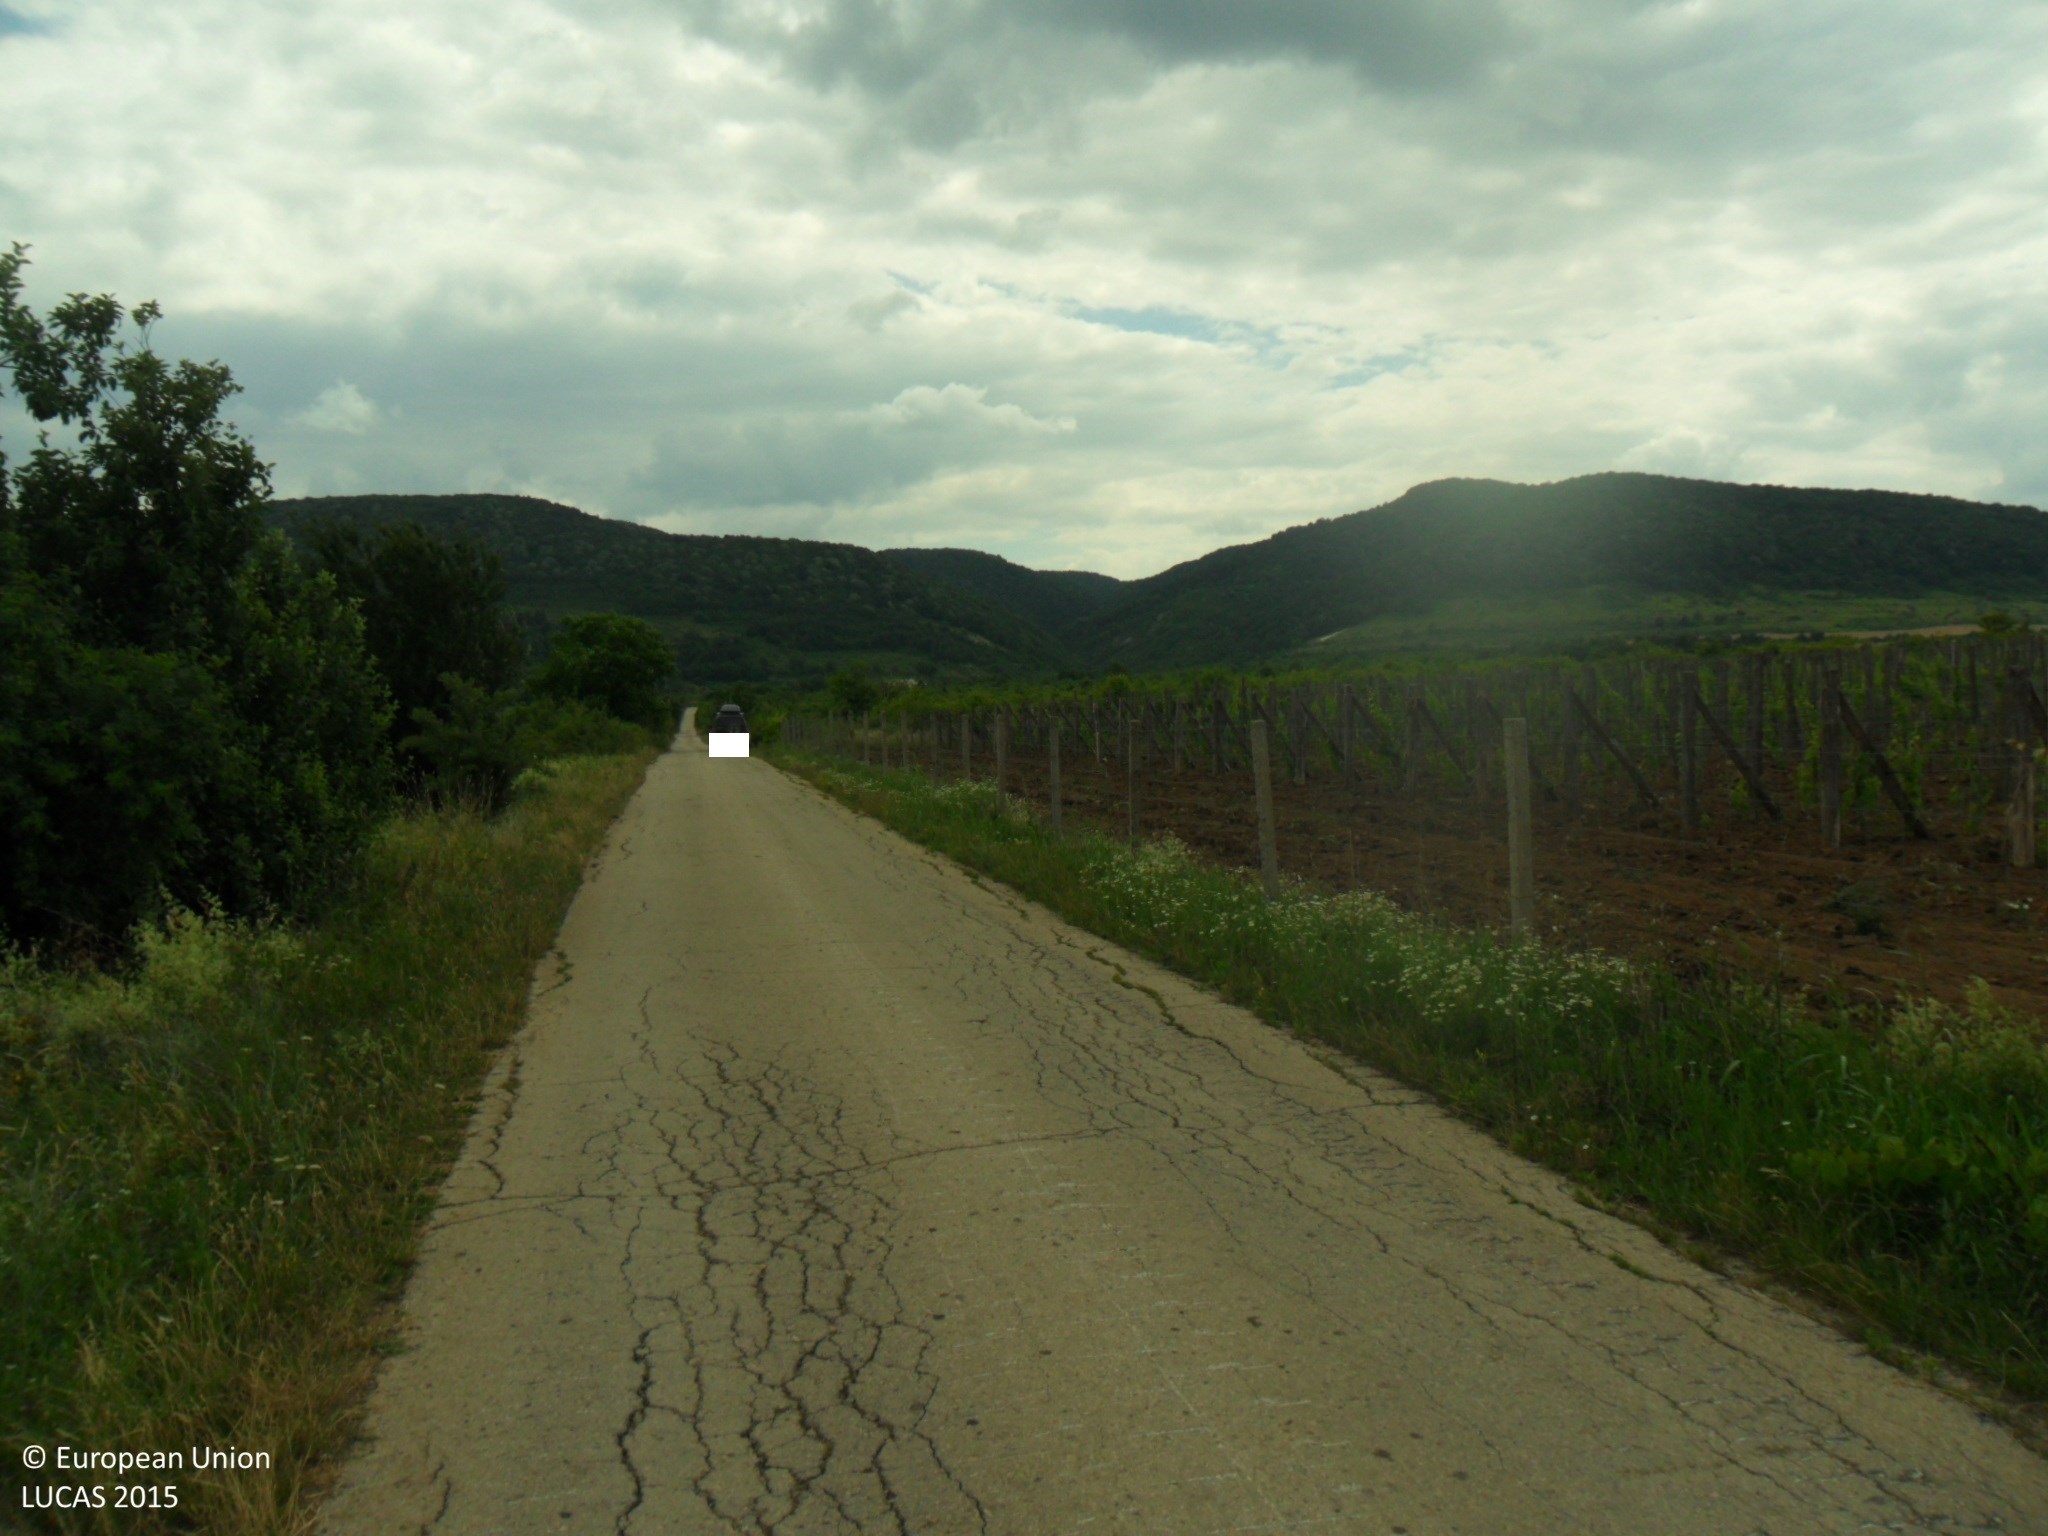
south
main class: Cropland
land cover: Vineyards
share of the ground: 10 - 25 %
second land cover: Other bare soil
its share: > 75 %
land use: Agriculture (excluding fallow land and kitchen gardens)
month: June
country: BG
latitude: 43.1024
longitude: 26.8814
